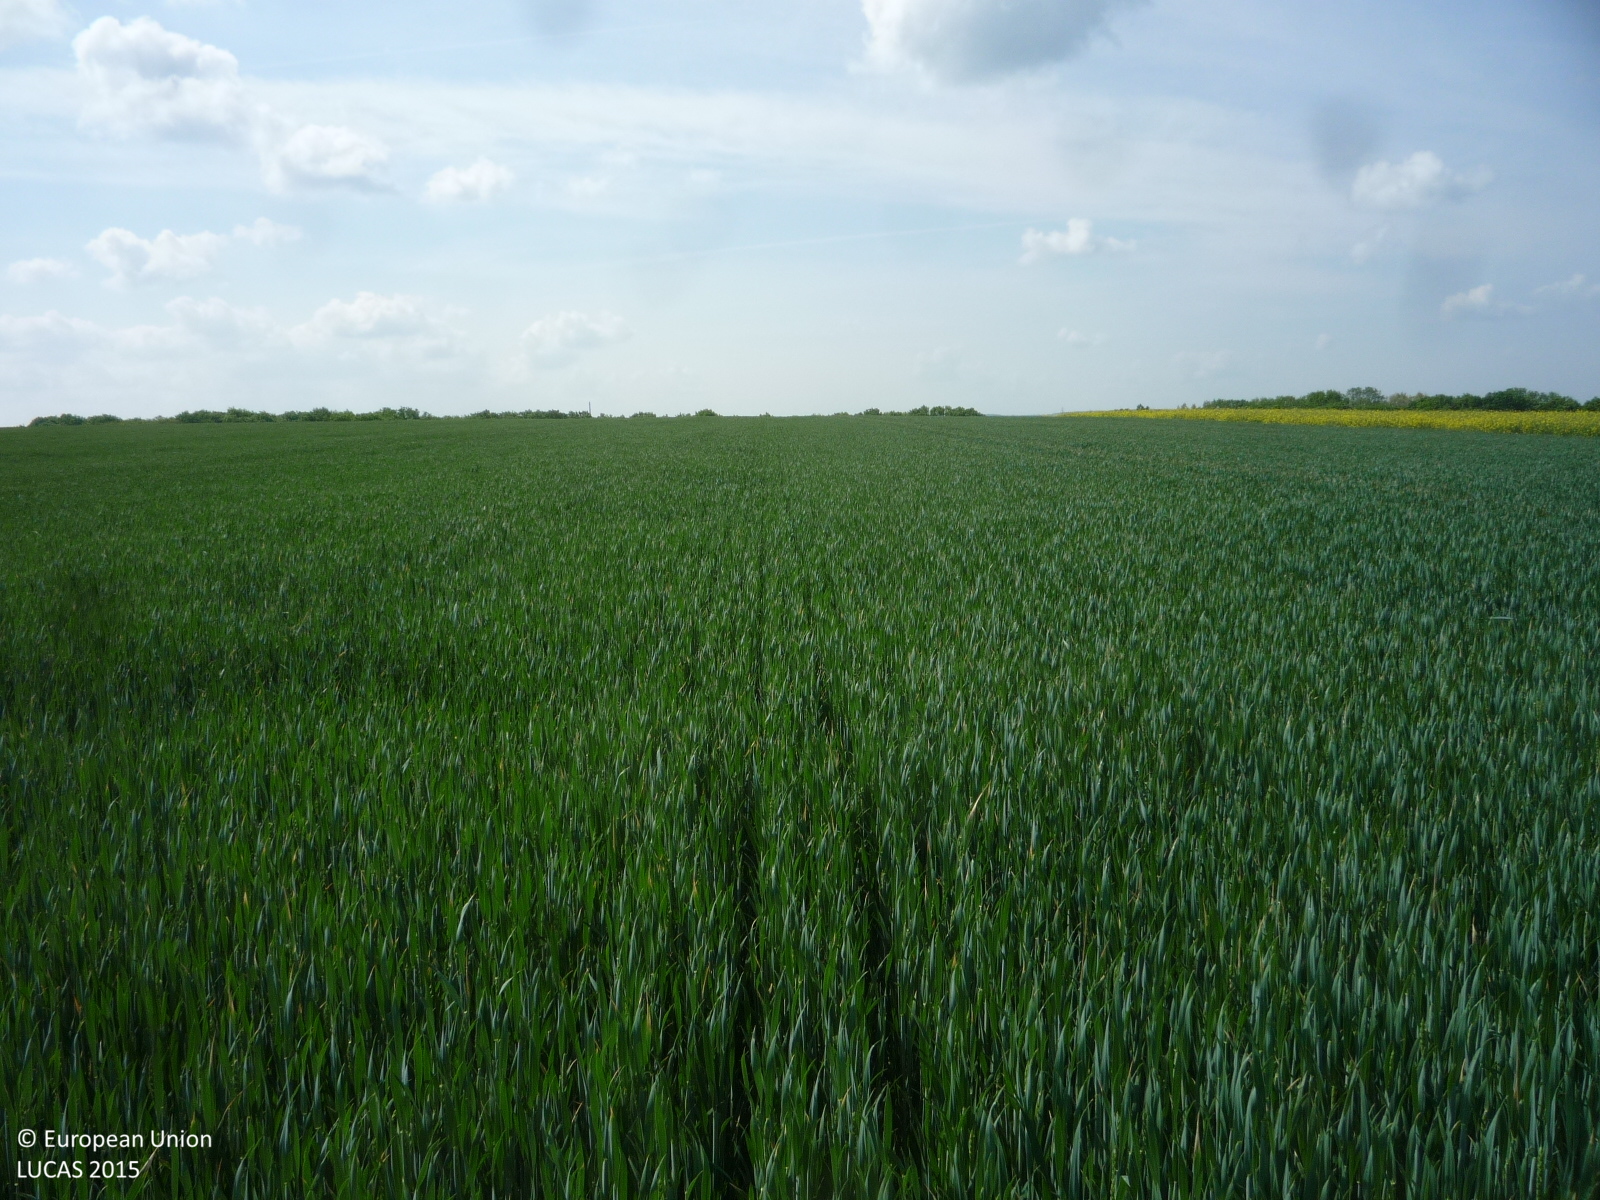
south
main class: Cropland
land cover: Common wheat
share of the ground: > 75 %
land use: Agriculture (excluding fallow land and kitchen gardens)
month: May
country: CZ
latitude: 50.0354
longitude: 14.6511
